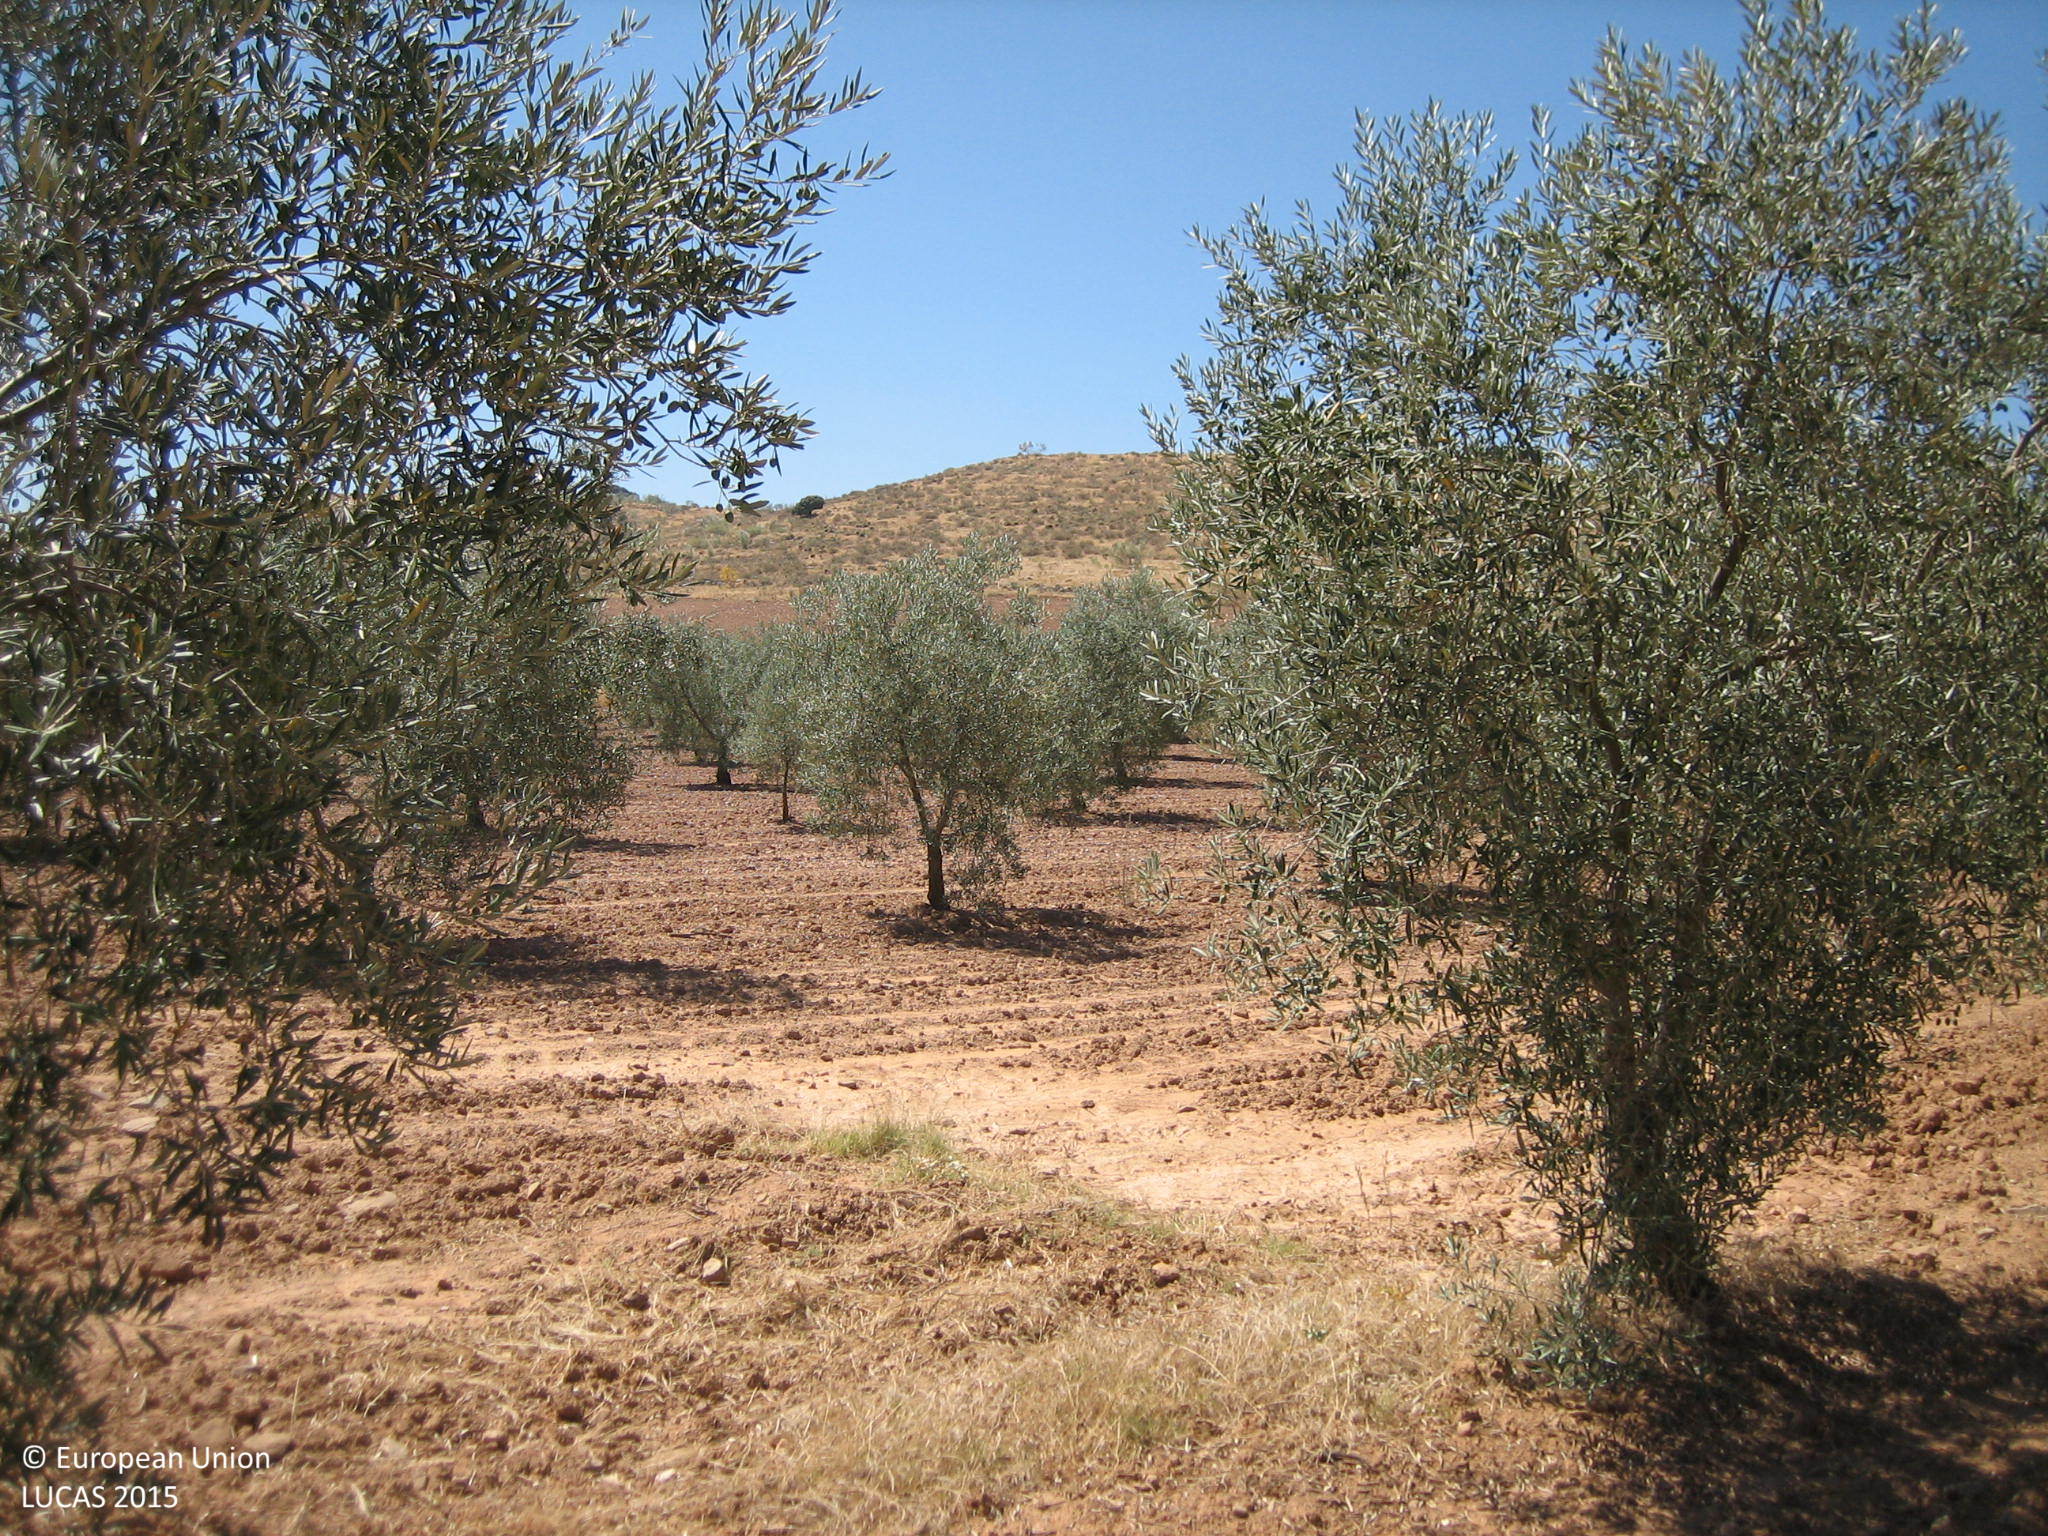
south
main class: Cropland
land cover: Olive groves
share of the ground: 25 - 50 %
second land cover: Other bare soil
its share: > 75 %
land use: Agriculture (excluding fallow land and kitchen gardens)
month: July
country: ES
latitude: 38.4287
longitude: -6.3264
